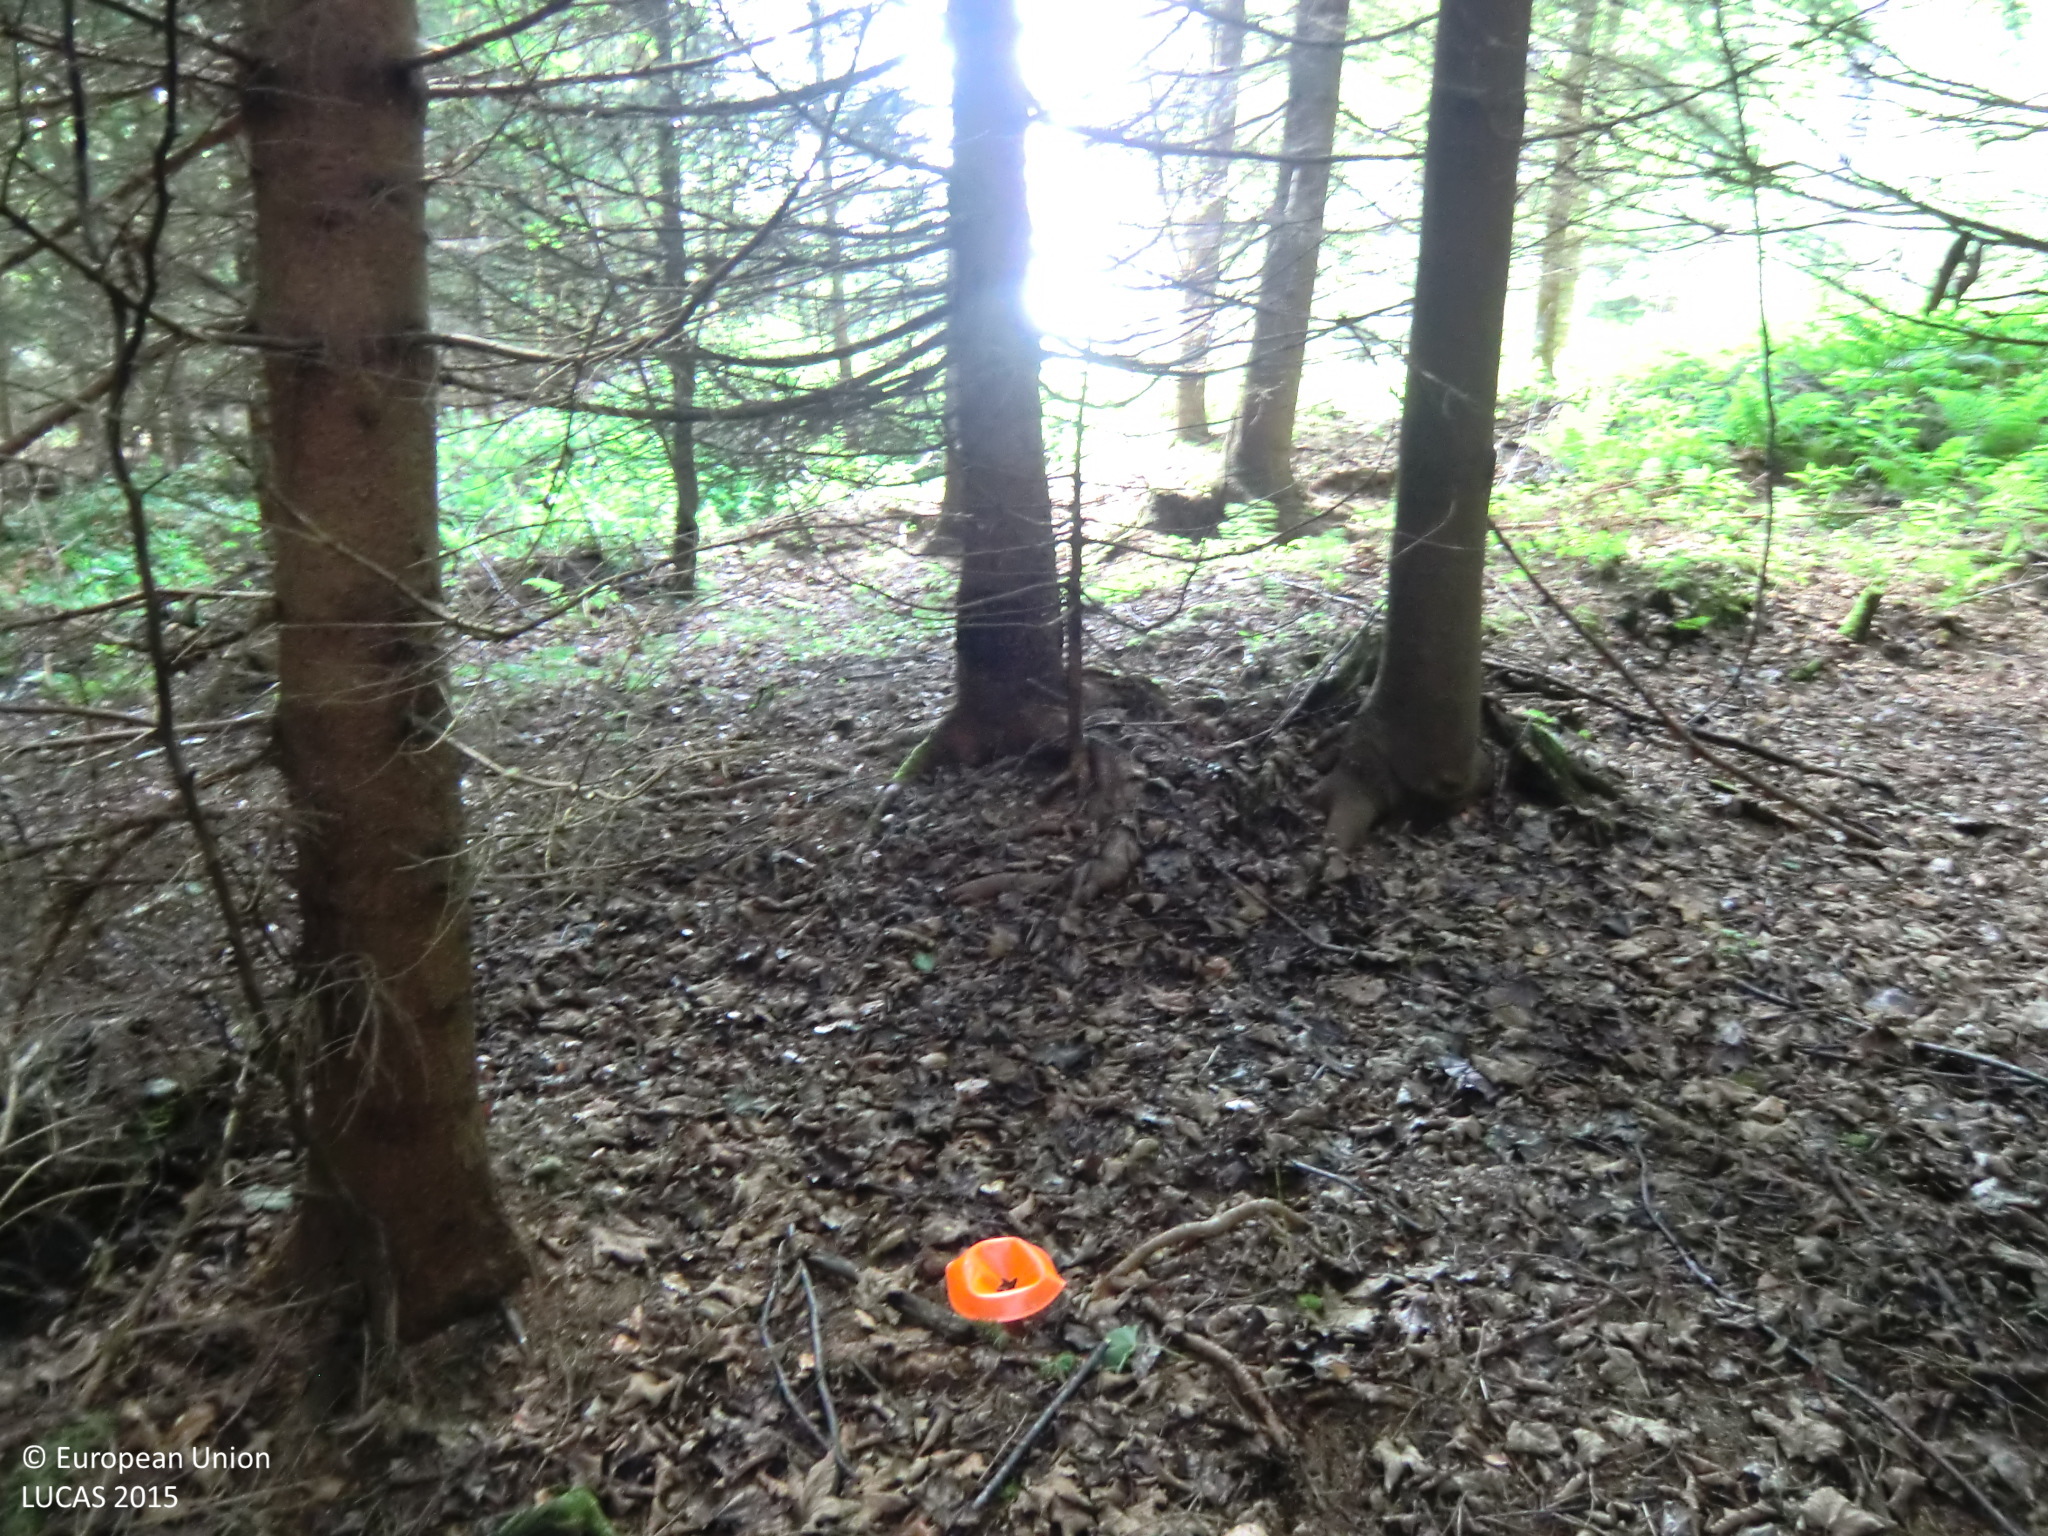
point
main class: Woodland
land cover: Spruce dominated coniferous woodland
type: hemiboreal forest and nemoral coniferous forest and mixed broadleaved-coniferous forest
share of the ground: > 75 %
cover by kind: coniferous forest trees 90 %, broadleaved forest trees 10 %
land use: Forestry
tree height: > 5 m
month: June
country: AT
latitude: 48.4770
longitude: 14.8577
